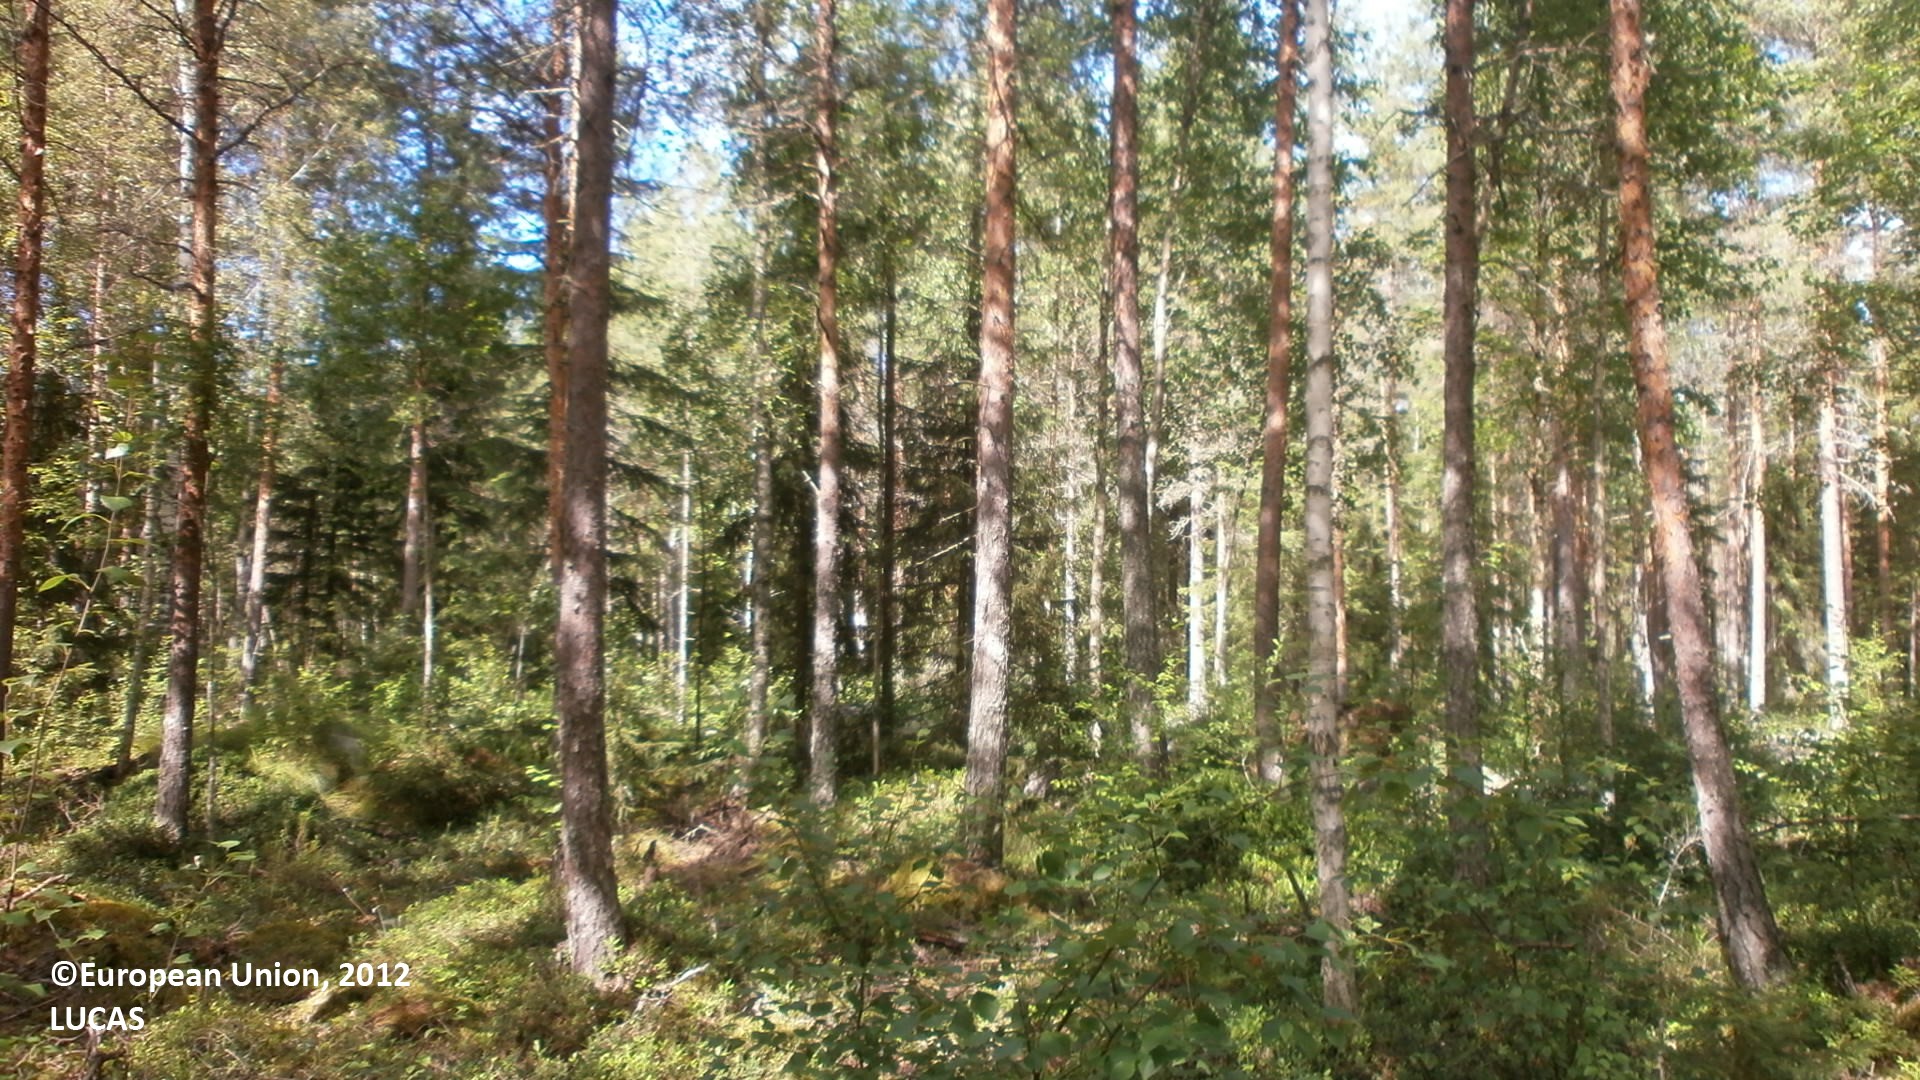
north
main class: Woodland
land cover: Pine dominated mixed woodland
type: boreal forest
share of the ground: 50 - 75 %
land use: Forestry
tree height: > 5 m
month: July
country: FI
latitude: 64.0063
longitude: 23.8671
